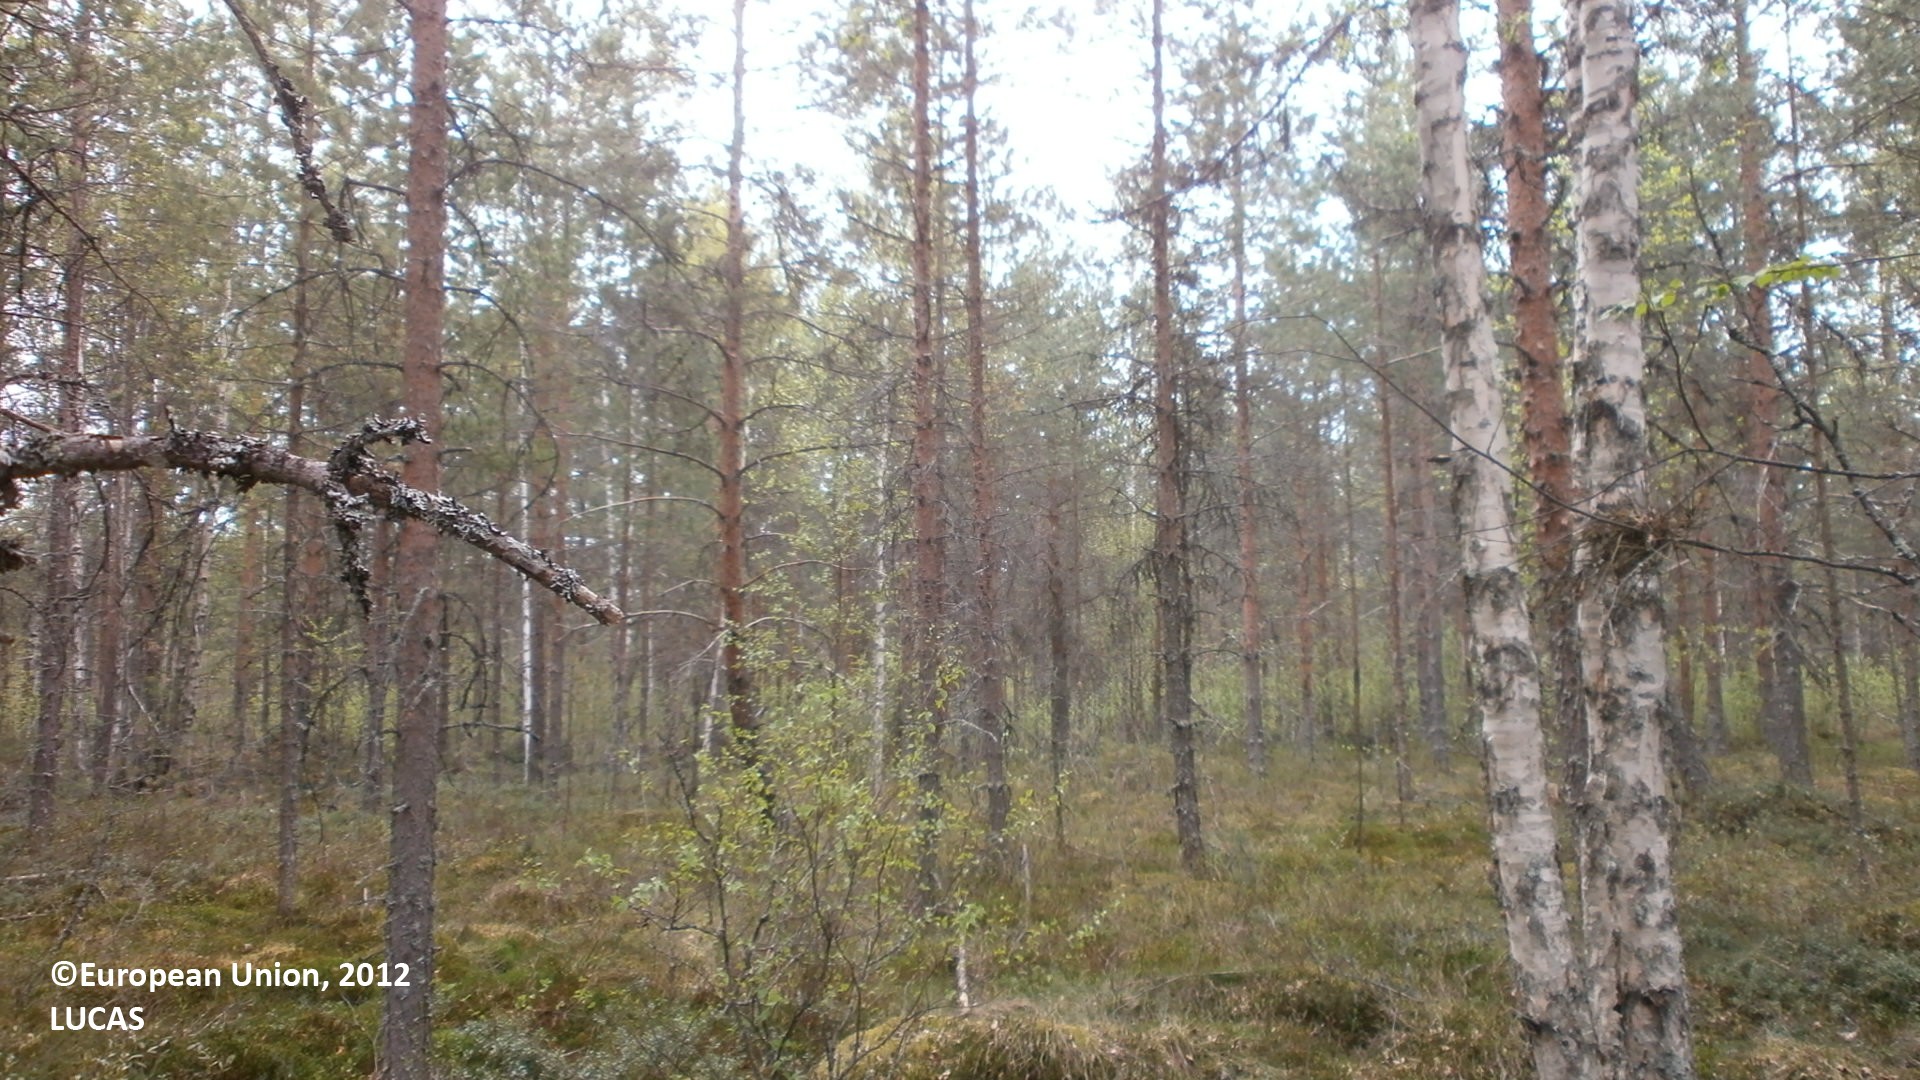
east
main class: Woodland
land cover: Pine dominated coniferous woodland
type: mire and swamp forests
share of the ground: > 75 %
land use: Forestry
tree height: > 5 m
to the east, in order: Pine dominated coniferous woodland; Pine dominated mixed woodland; Ditches and canals; Pine dominated coniferous woodland; Ditches and canals; Pine dominated coniferous woodland; Ditches and canals; Pine dominated coniferous woodland; Ditches and canals; Pine dominated coniferous woodland; Ditches and canals; Pine dominated coniferous woodland; Ditches and canals; Pine dominated coniferous woodland; Pine dominated mixed woodland; Ditches and canals; Pine dominated coniferous woodland
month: May
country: FI
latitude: 64.4744
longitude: 25.9284
